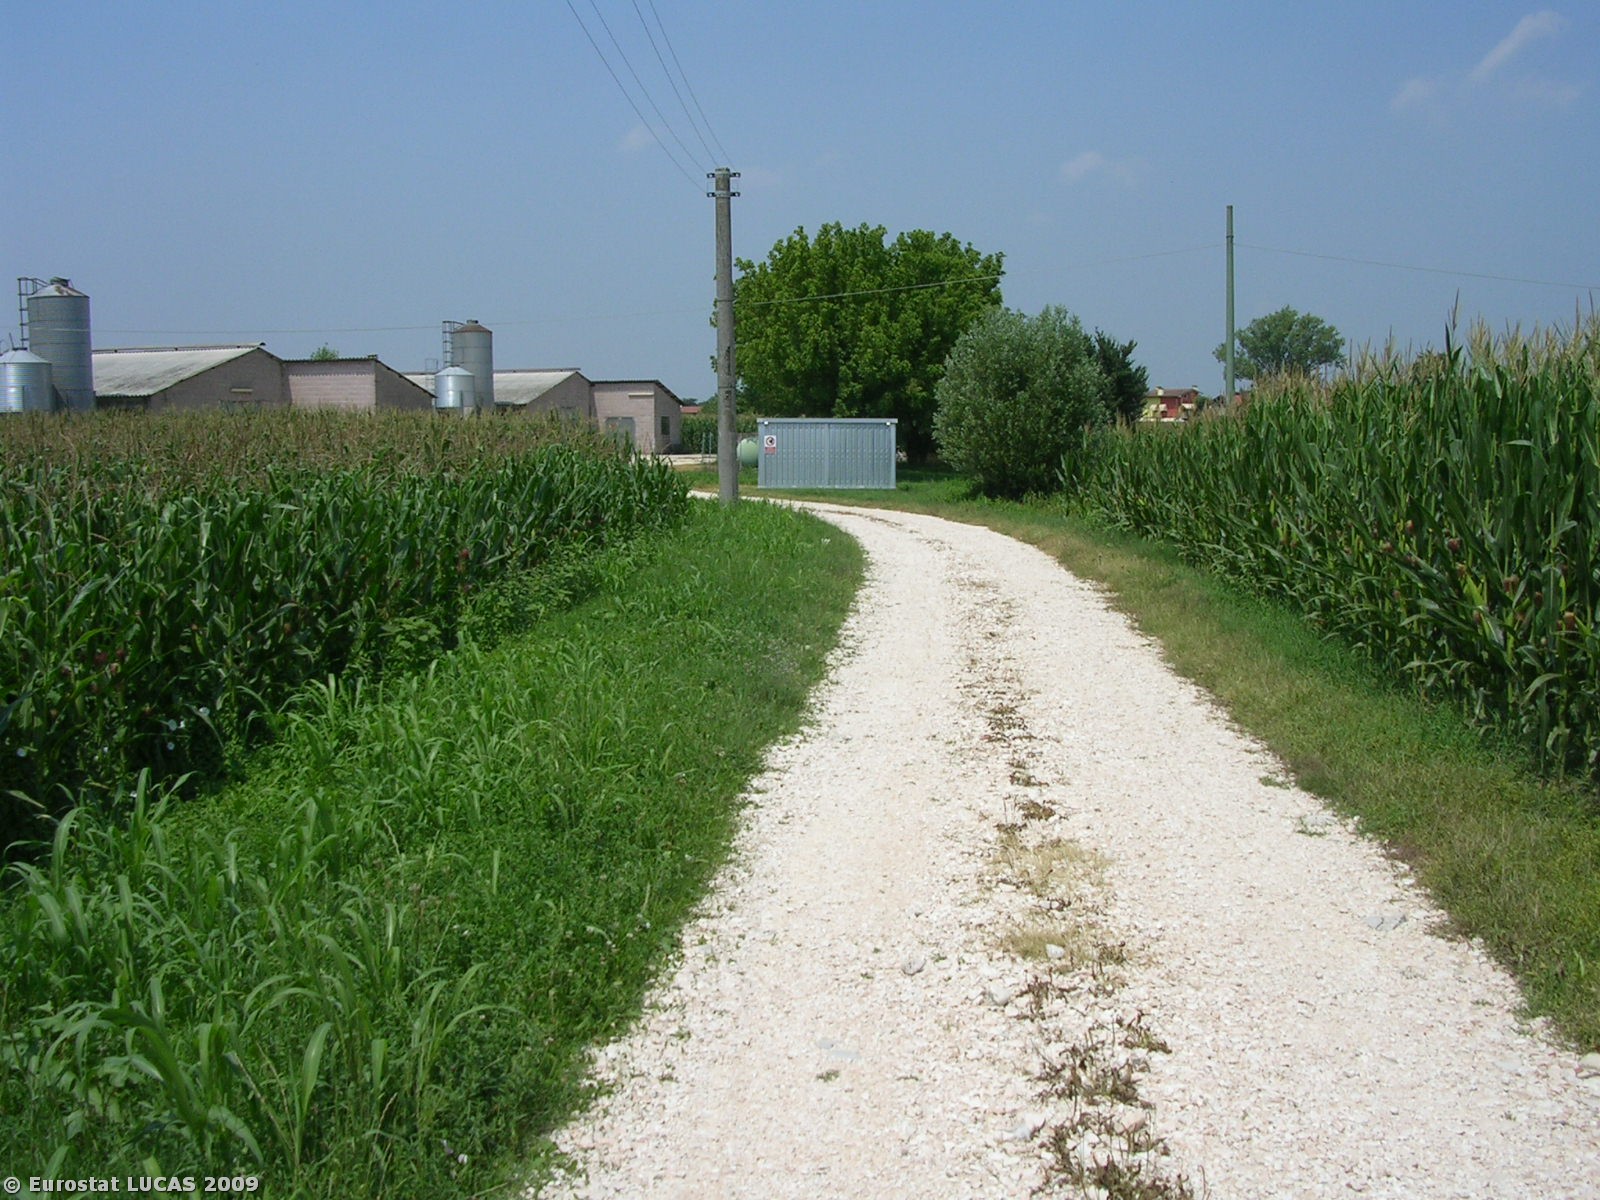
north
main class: Cropland
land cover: Maize
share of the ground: > 75 %
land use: Agriculture (excluding fallow land and kitchen gardens)
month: July
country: IT
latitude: 45.4539
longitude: 11.7490
